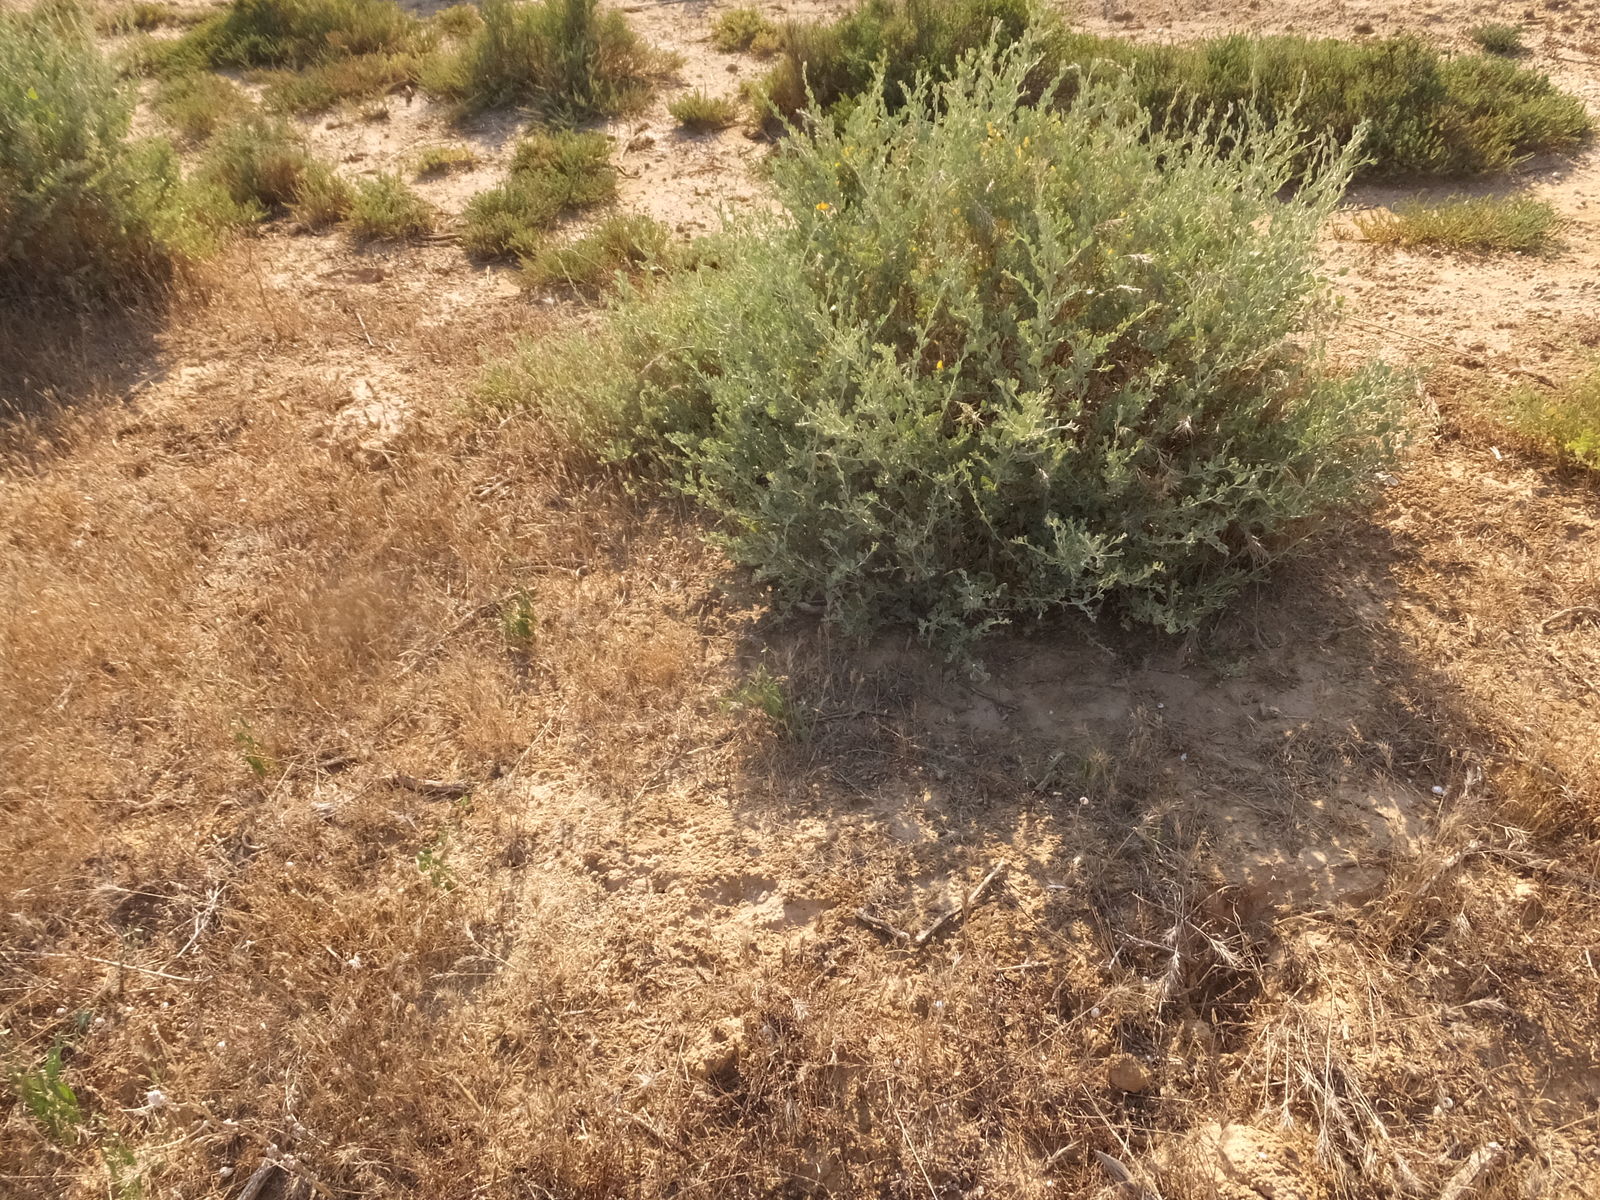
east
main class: Shrubland
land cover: Shrubland without tree cover
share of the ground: 10 - 25 %
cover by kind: herbaceous plants 75 %, shrubs 25 %
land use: Abandoned areas
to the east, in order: Shrubland without tree cover; Shruby margins; Barley
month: July
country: ES
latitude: 41.7359
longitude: 0.3307
